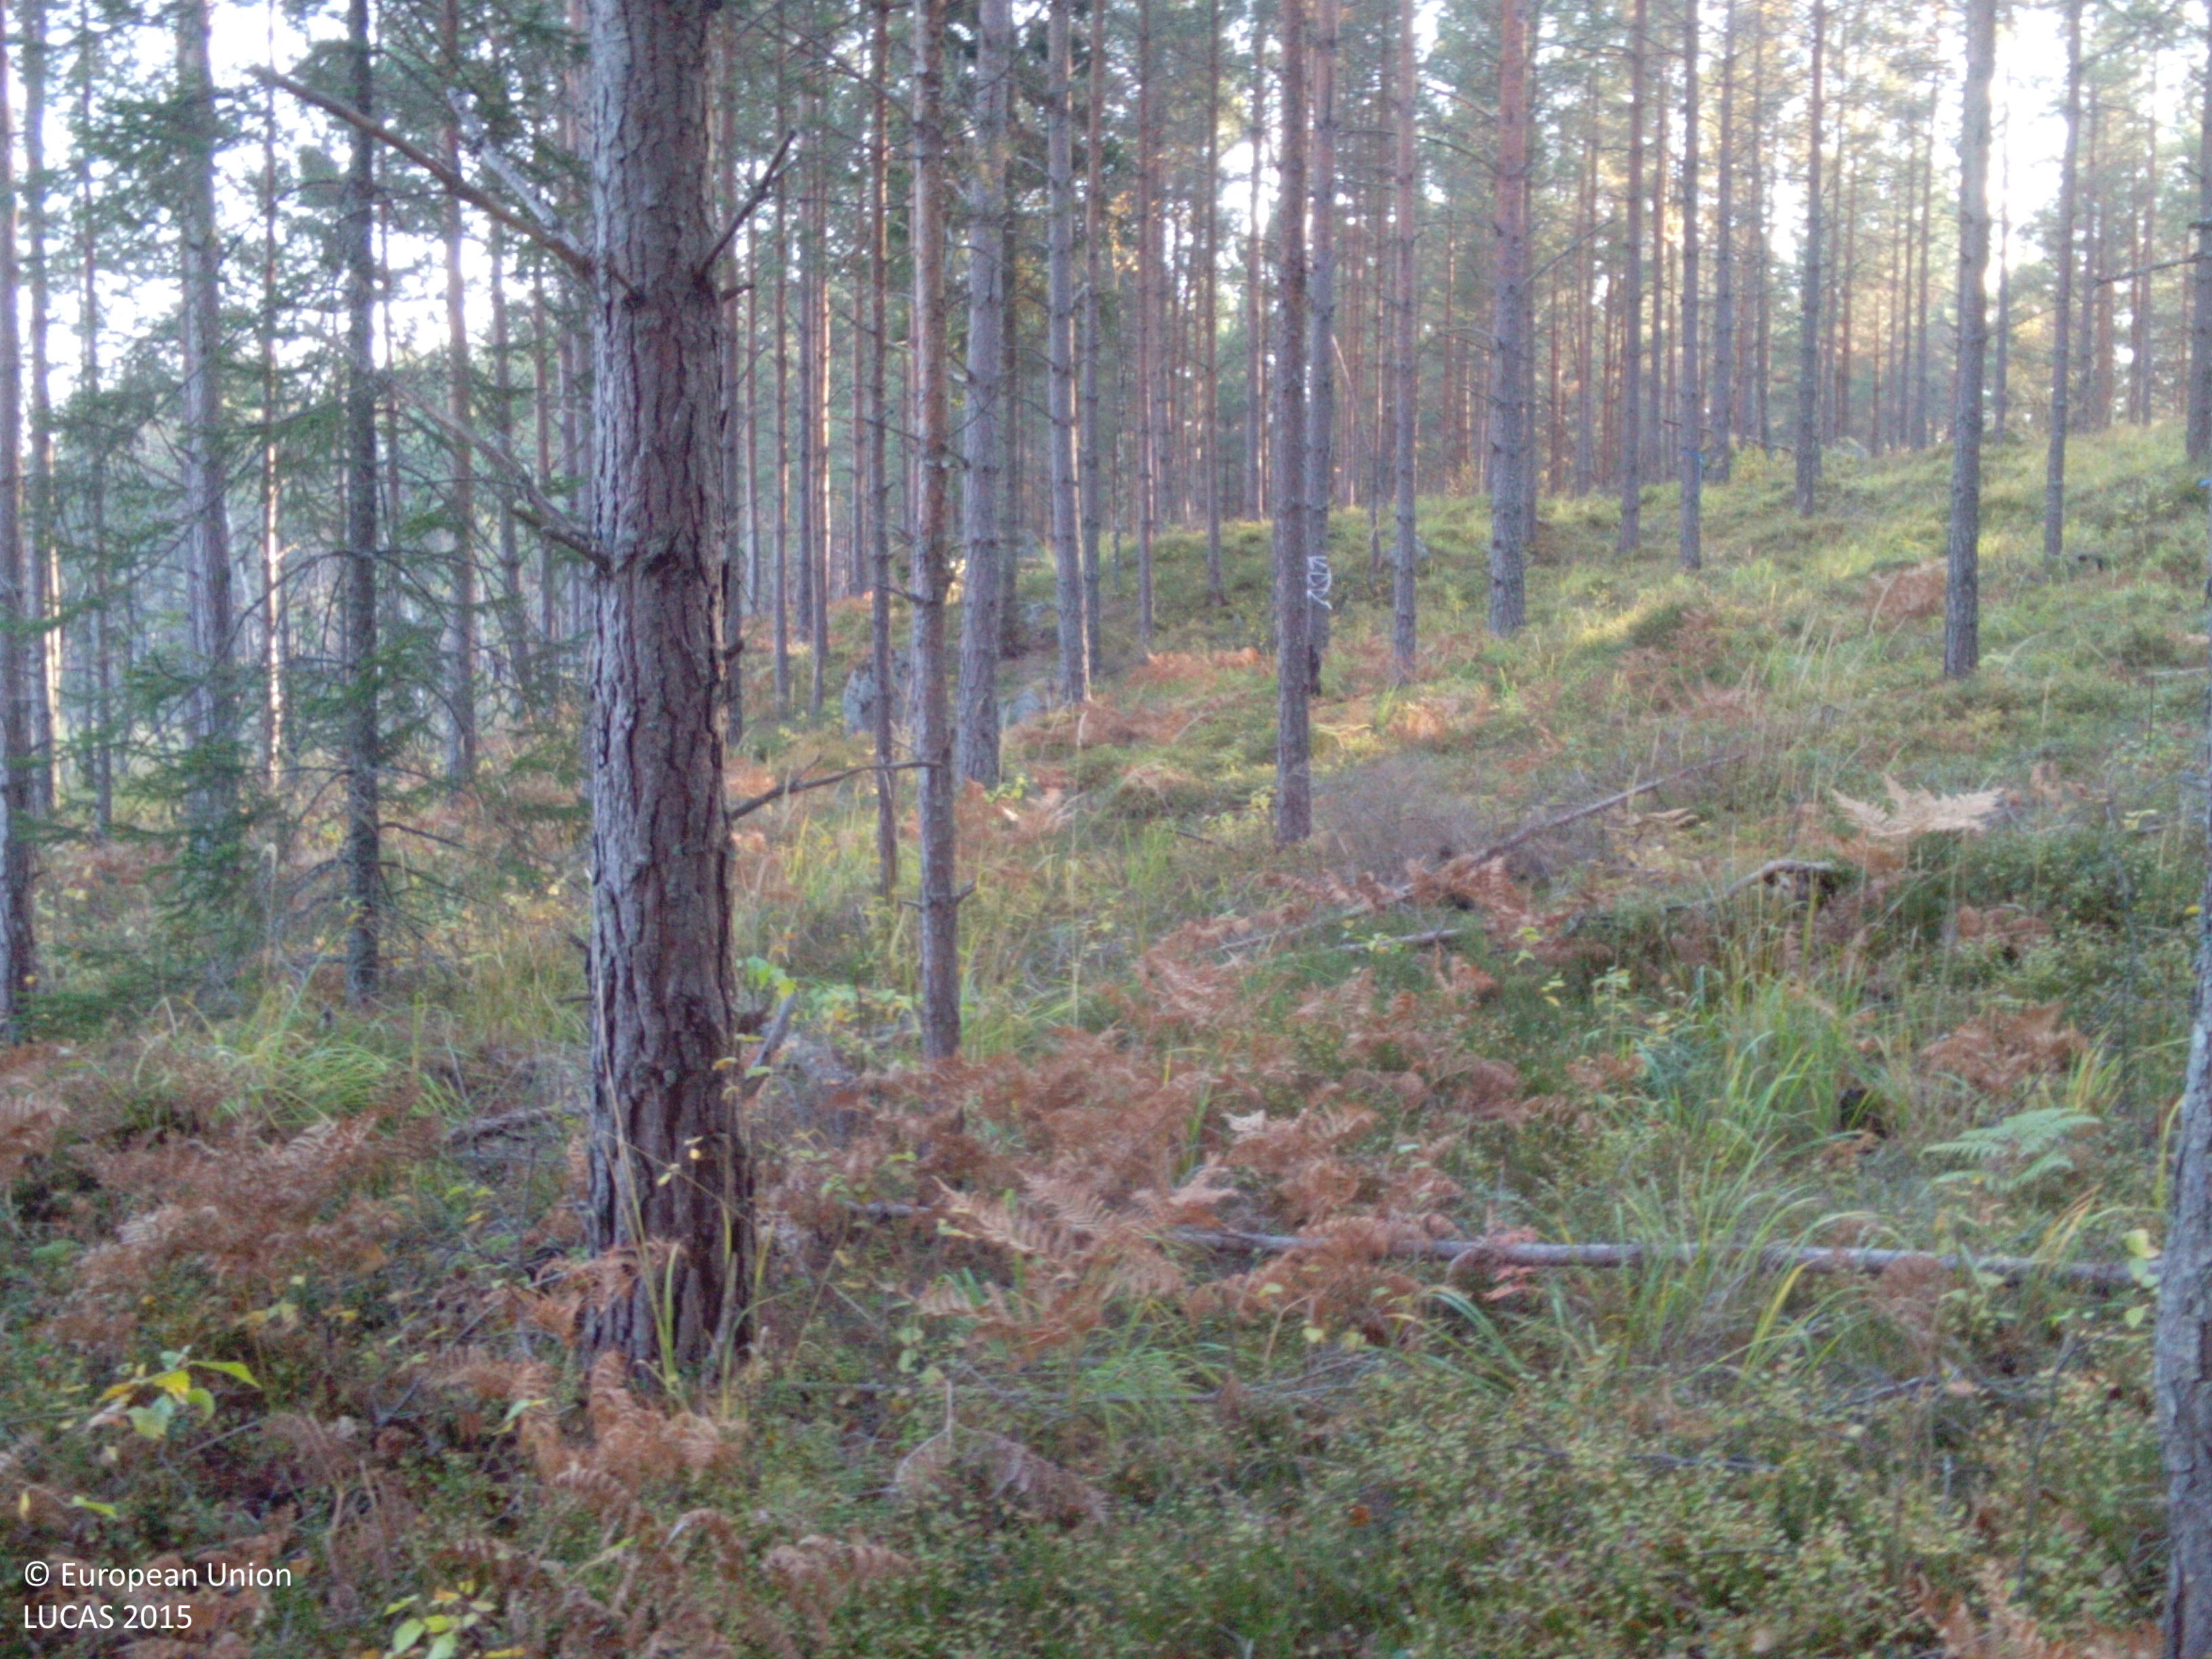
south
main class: Woodland
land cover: Pine dominated coniferous woodland
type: boreal forest
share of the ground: > 75 %
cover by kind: coniferous forest trees 85 %, herbaceous plants 10 %, lichens and mosses 5 %
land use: Forestry
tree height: > 5 m
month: October
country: SE
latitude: 58.8650
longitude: 16.3234
